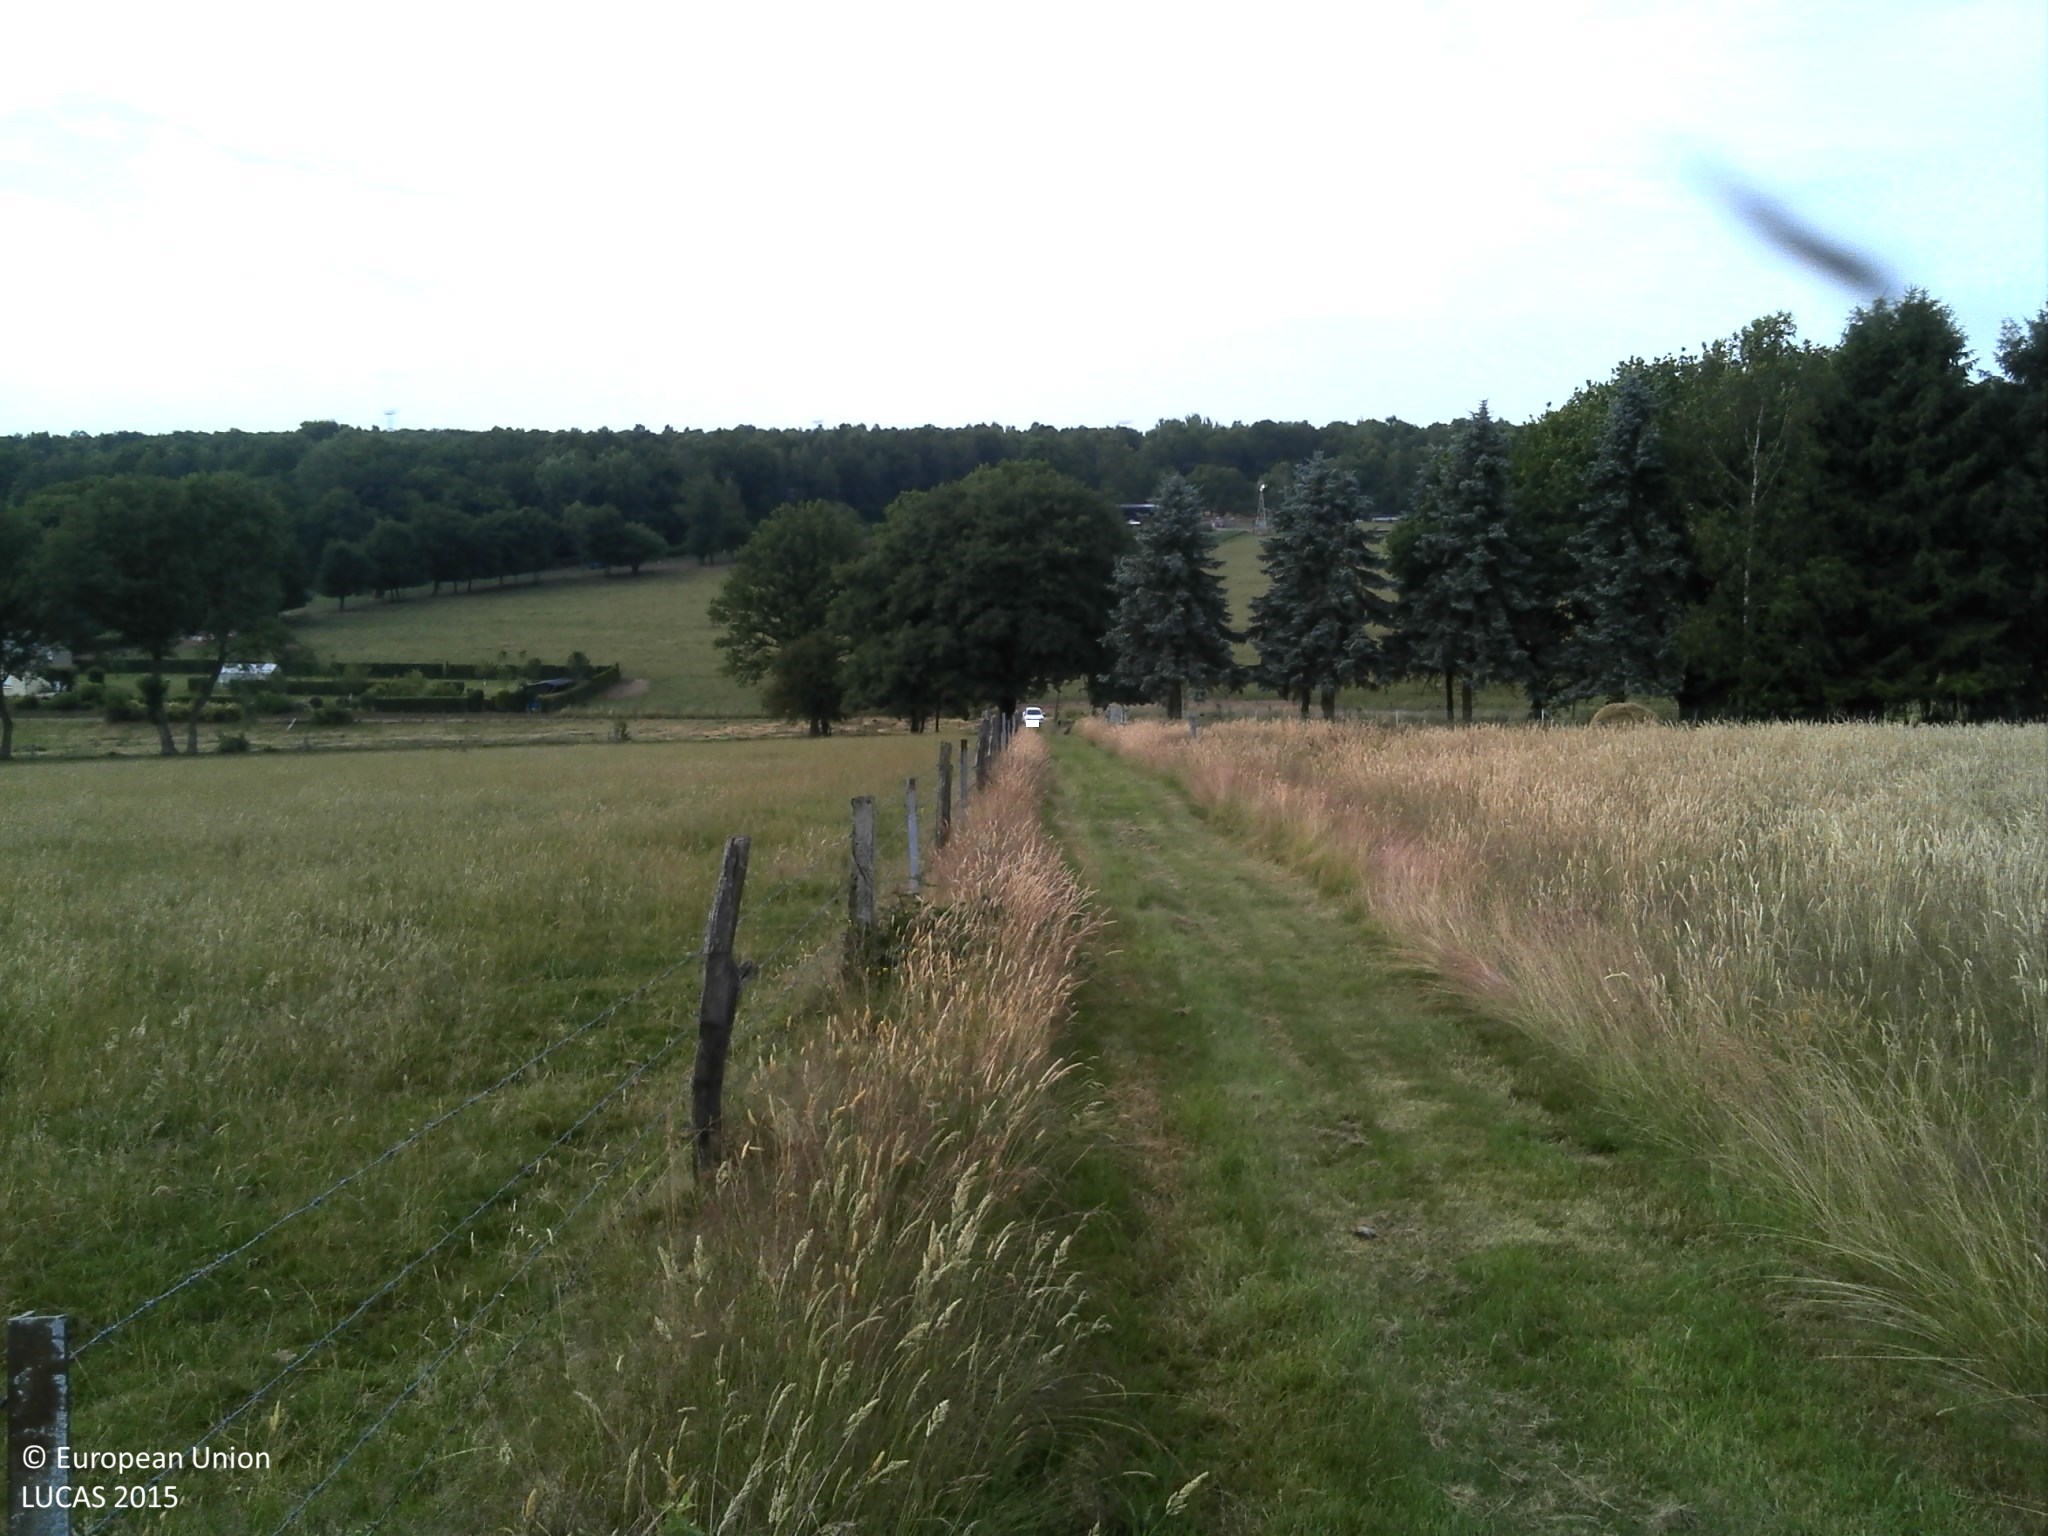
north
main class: Grassland
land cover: Grassland without tree/shrub cover
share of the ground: > 75 %
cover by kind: herbaceous plants 100 %
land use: Agriculture (excluding fallow land and kitchen gardens)
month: July
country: FR
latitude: 49.8613
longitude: 4.6686
